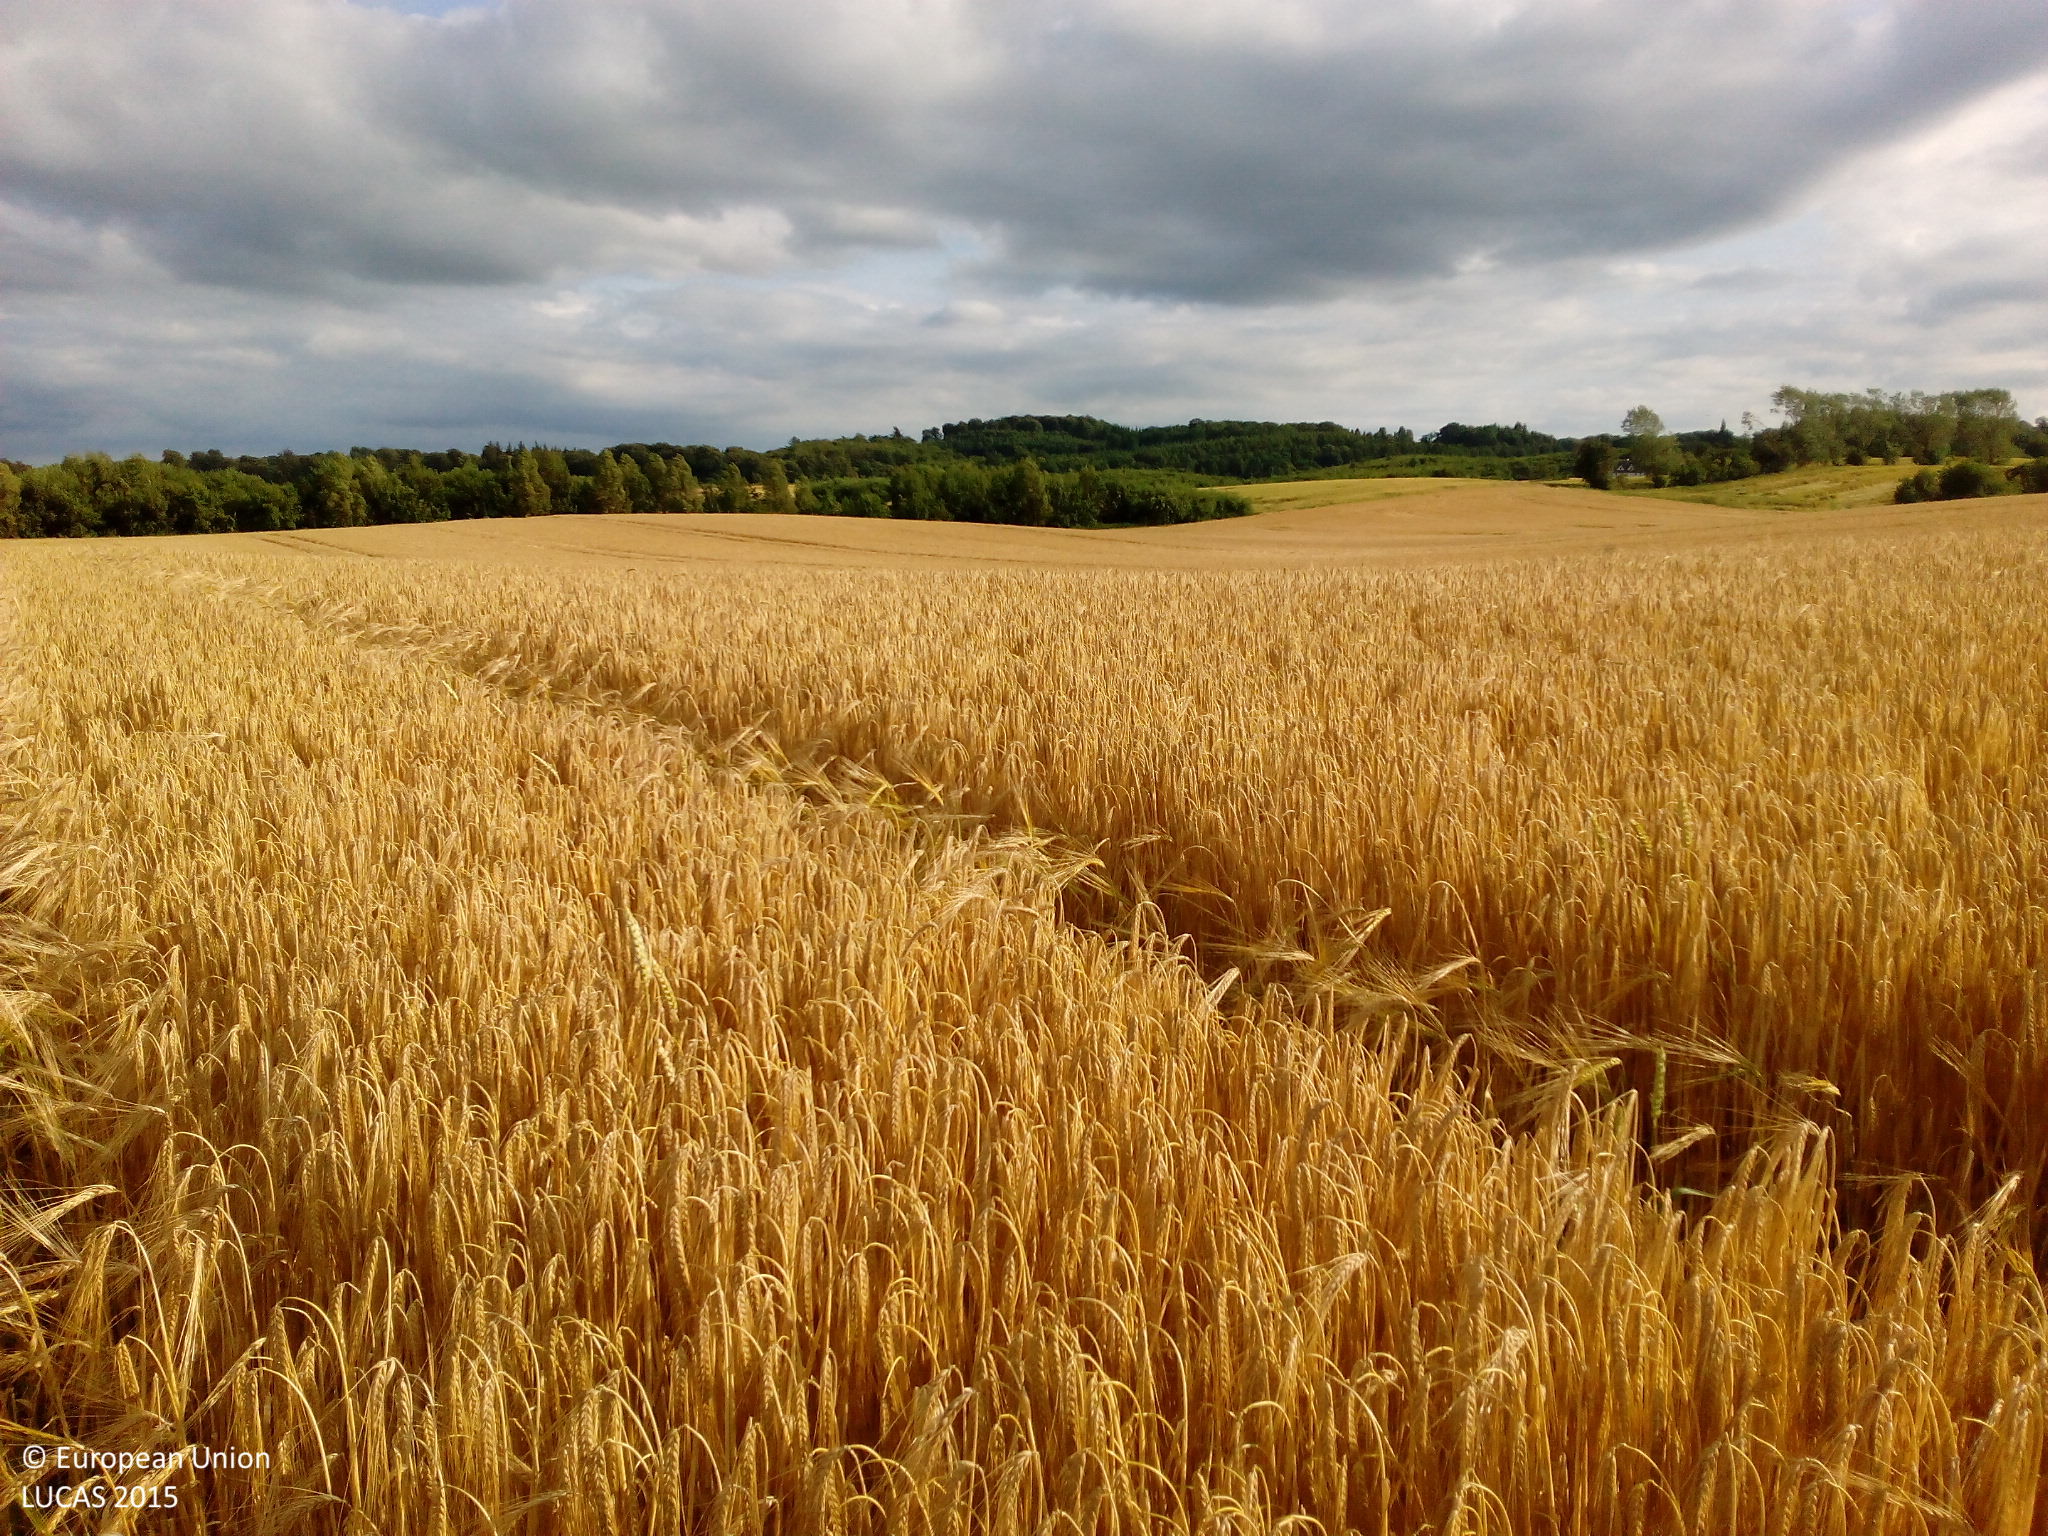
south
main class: Cropland
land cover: Barley
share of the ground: > 75 %
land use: Agriculture (excluding fallow land and kitchen gardens)
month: July
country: DK
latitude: 55.6945
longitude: 11.4146
